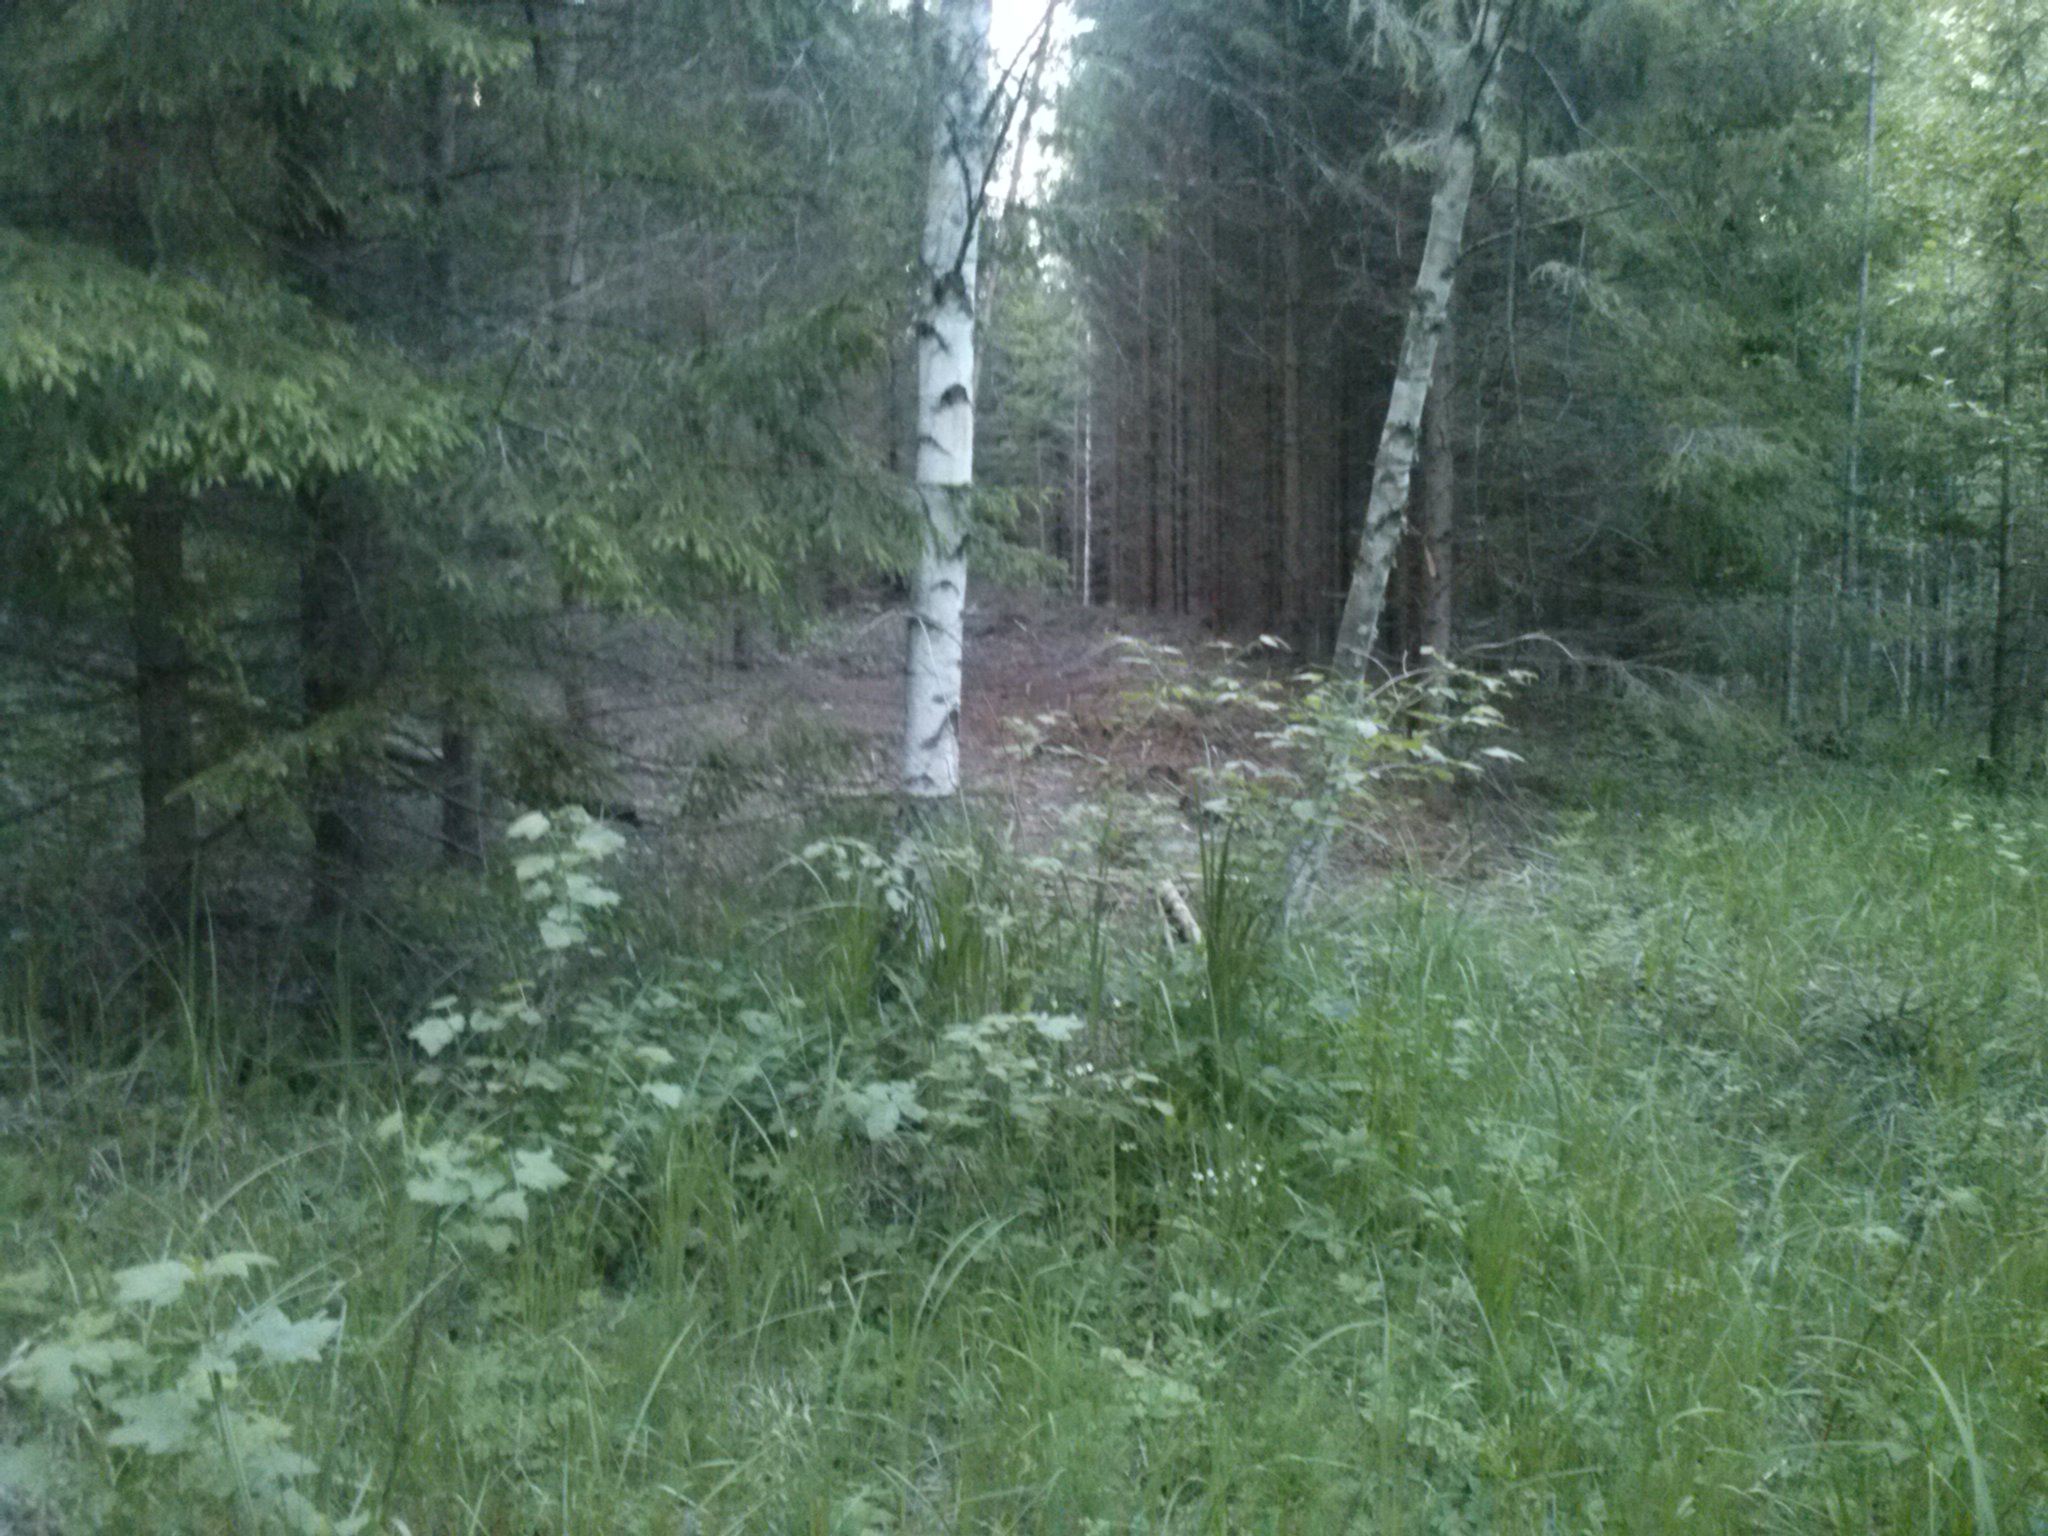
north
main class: Woodland
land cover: Spruce dominated mixed woodland
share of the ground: 50 - 75 %
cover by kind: coniferous forest trees 35 %, herbaceous plants 30 %, broadleaved forest trees 25 %, shrubs 10 %
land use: Forestry
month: May
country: LV
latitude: 56.3612
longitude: 27.8511
